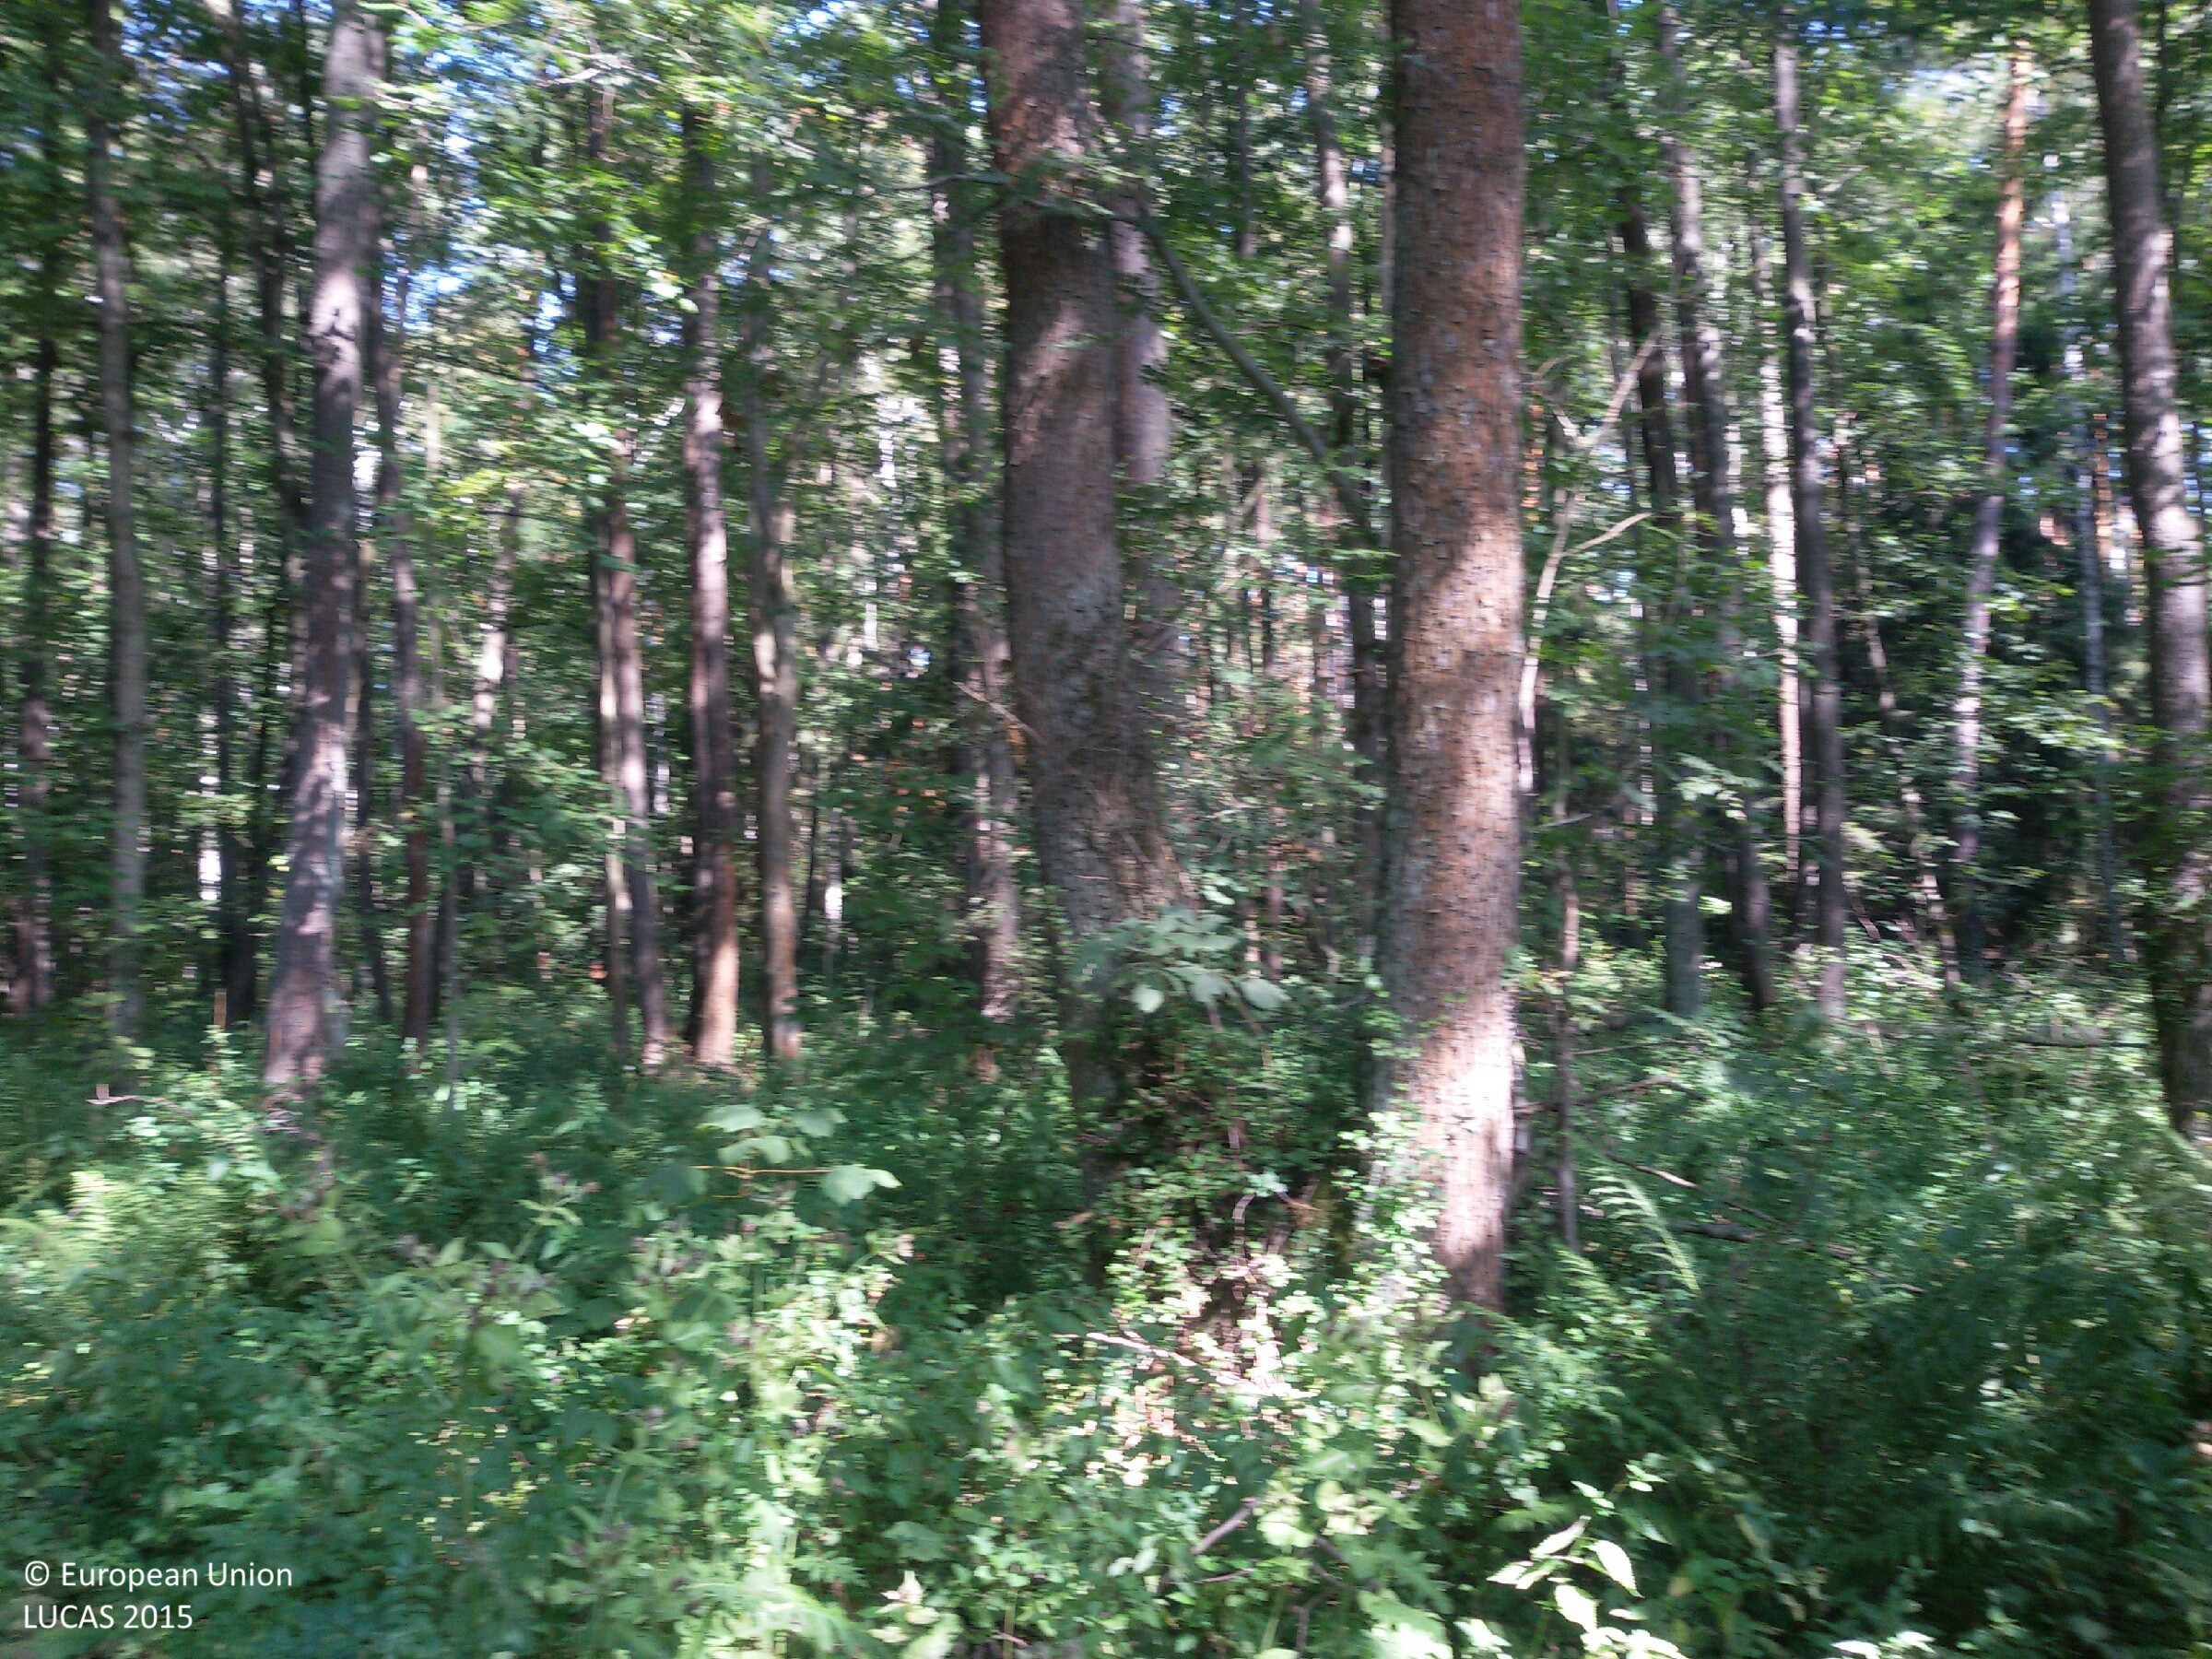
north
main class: Woodland
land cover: Broadleaved woodland
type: mesophytic deciduous forest
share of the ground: > 75 %
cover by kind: broadleaved forest trees 95 %, coniferous forest trees 5 %
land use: Forestry
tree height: > 5 m
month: August
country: PL
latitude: 50.6792
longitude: 20.8689
